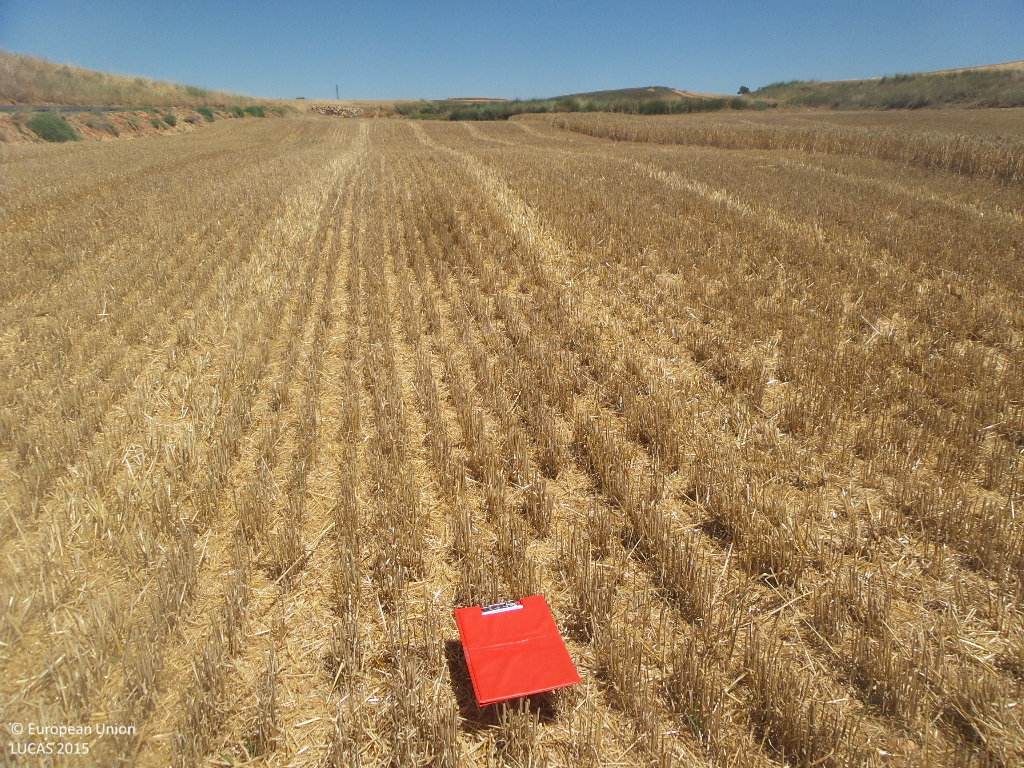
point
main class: Cropland
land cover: Barley
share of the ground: < 10 %
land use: Agriculture (excluding fallow land and kitchen gardens)
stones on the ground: < 10 %
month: July
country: ES
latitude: 41.3968
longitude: -2.0983
